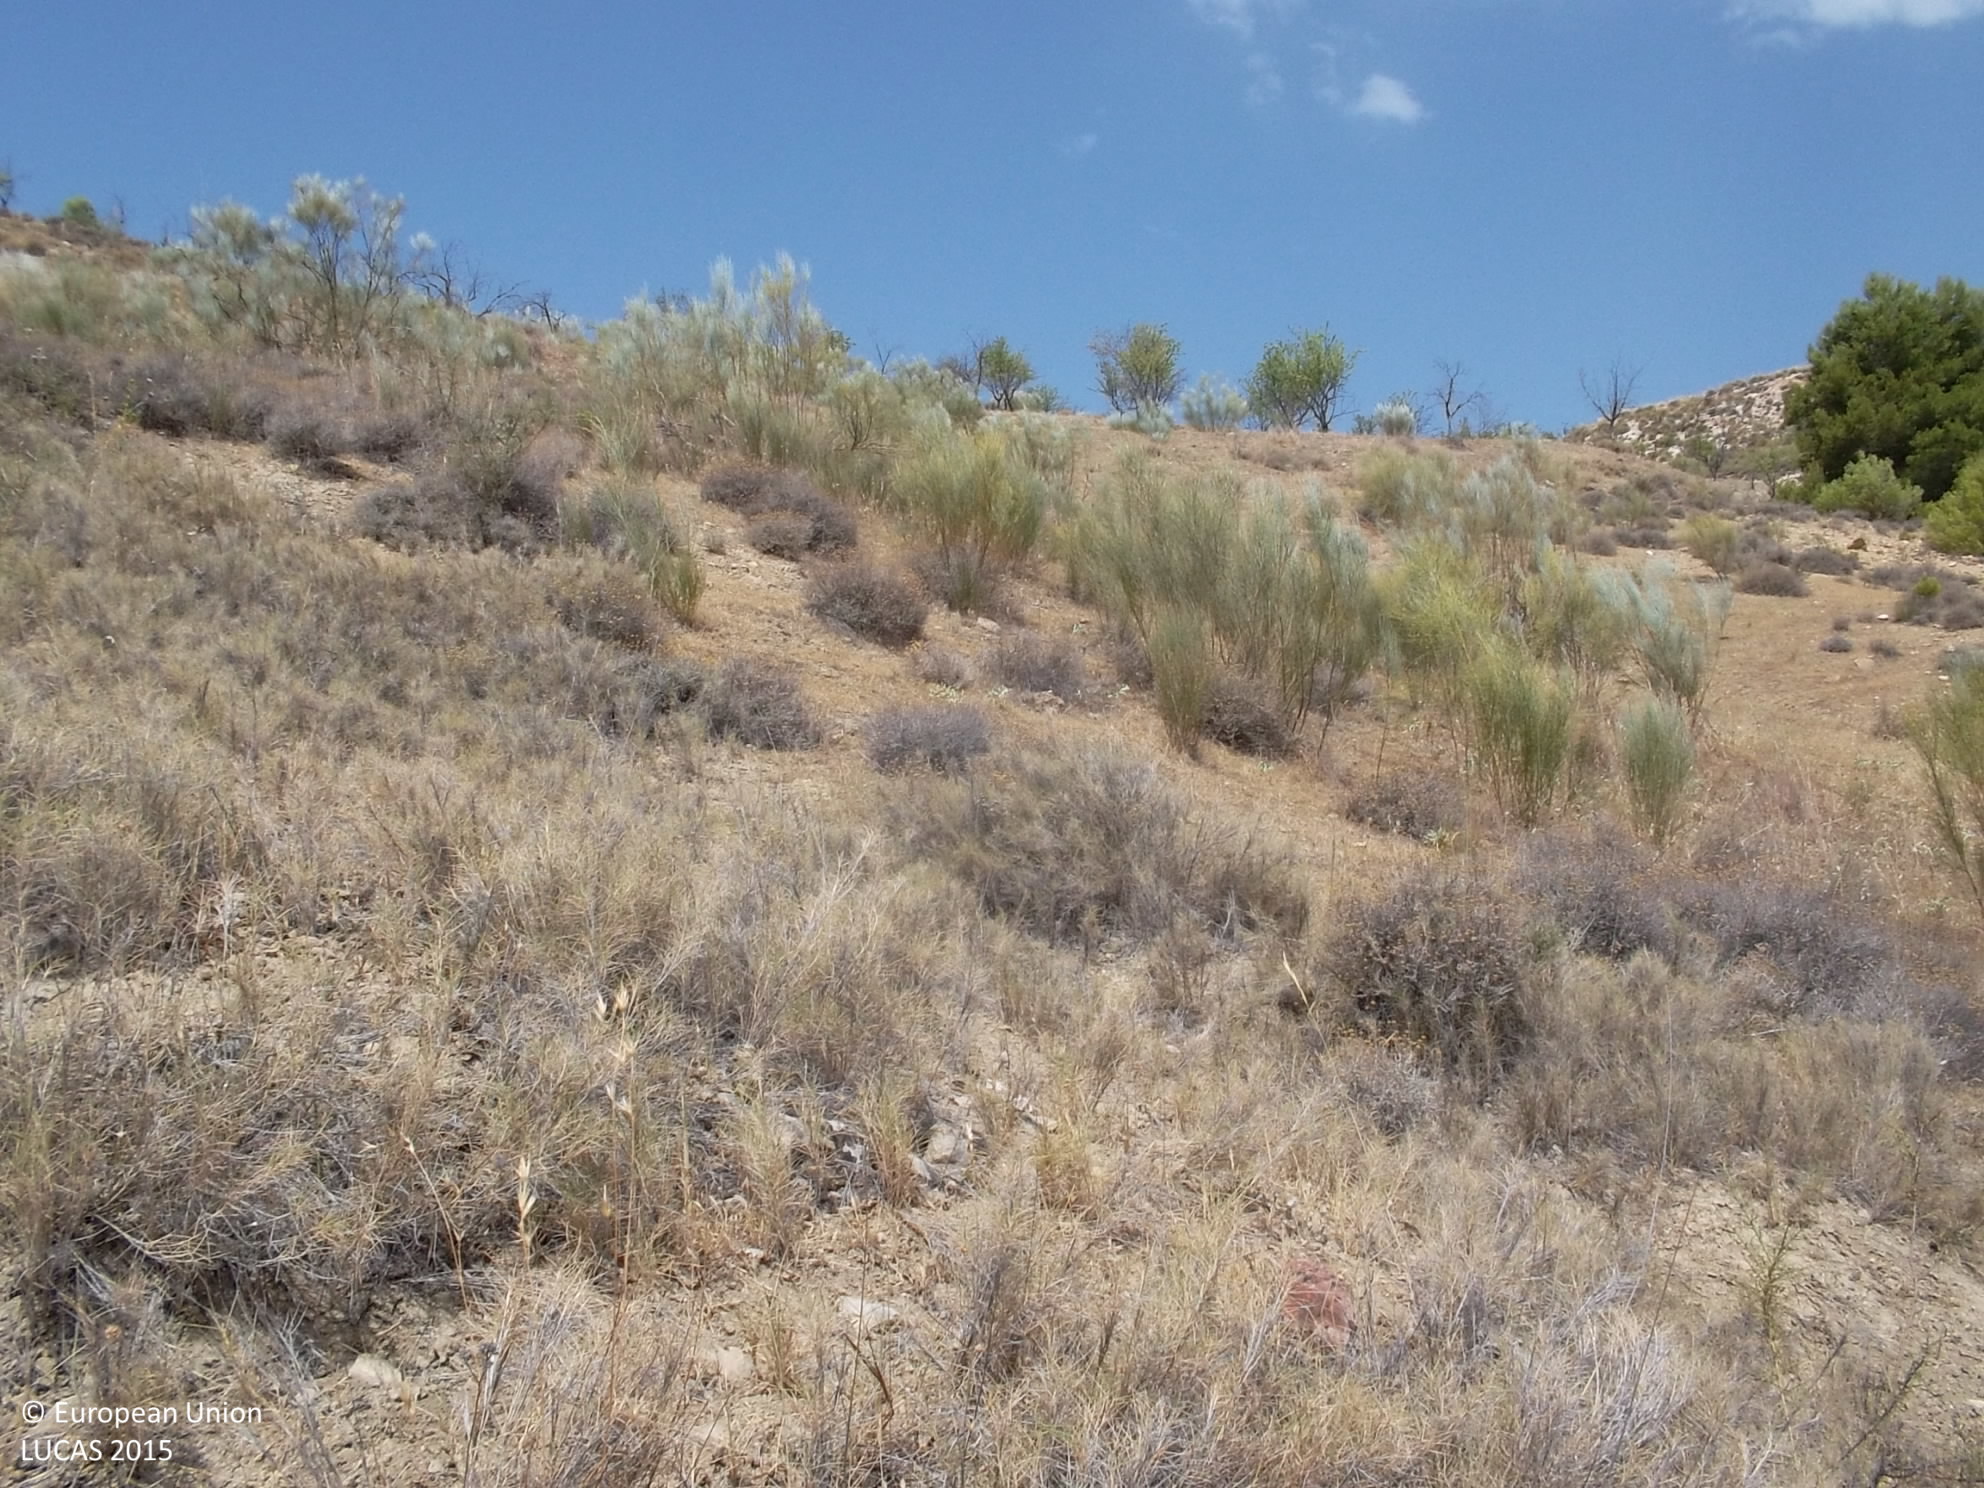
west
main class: Grassland
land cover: Grassland with sparse tree/shrub cover
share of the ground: > 75 %
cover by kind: herbaceous plants 90 %, coniferous forest trees 5 %, shrubs 5 %
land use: Agriculture (excluding fallow land and kitchen gardens)
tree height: < 5 m
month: July
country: ES
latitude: 37.7400
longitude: -2.8028
